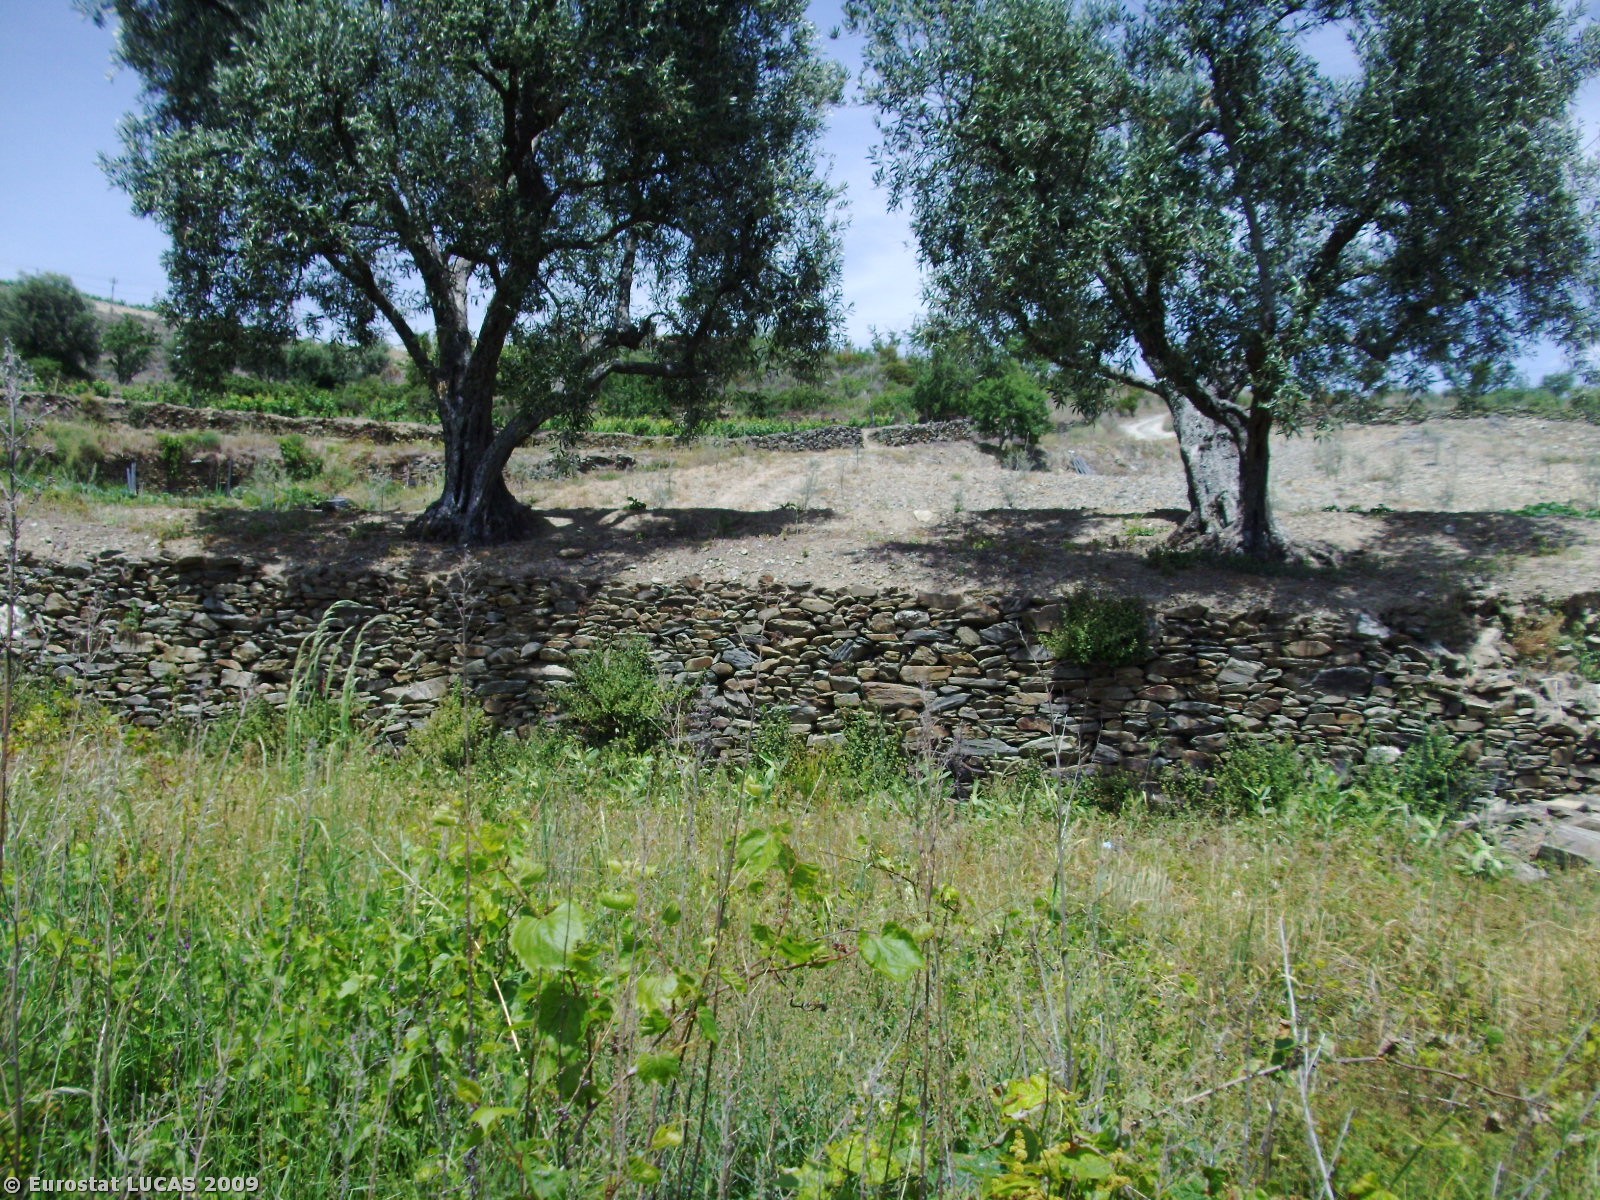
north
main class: Shrubland
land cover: Shrubland without tree cover
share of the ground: > 75 %
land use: Fallow land
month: May
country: PT
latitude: 41.1169
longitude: -7.4971
